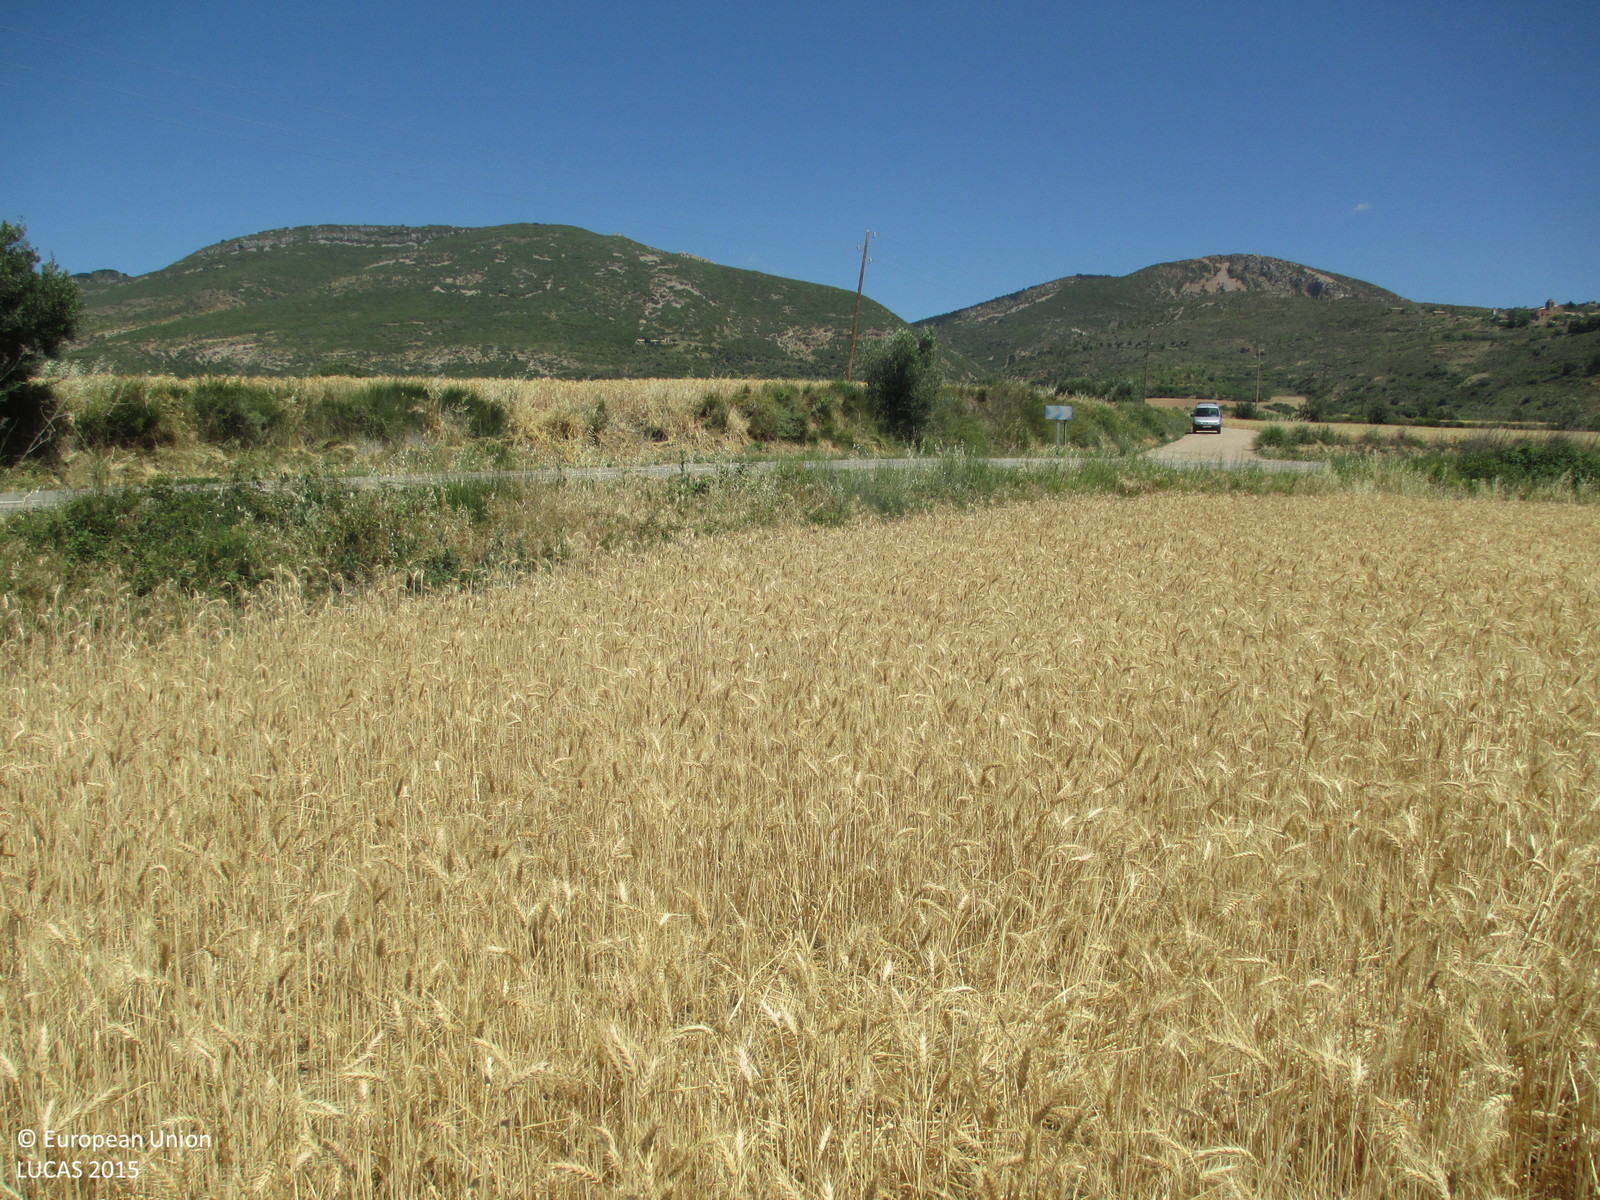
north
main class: Cropland
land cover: Durum wheat
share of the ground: > 75 %
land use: Agriculture (excluding fallow land and kitchen gardens)
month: June
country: ES
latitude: 42.1999
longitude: -0.3044
